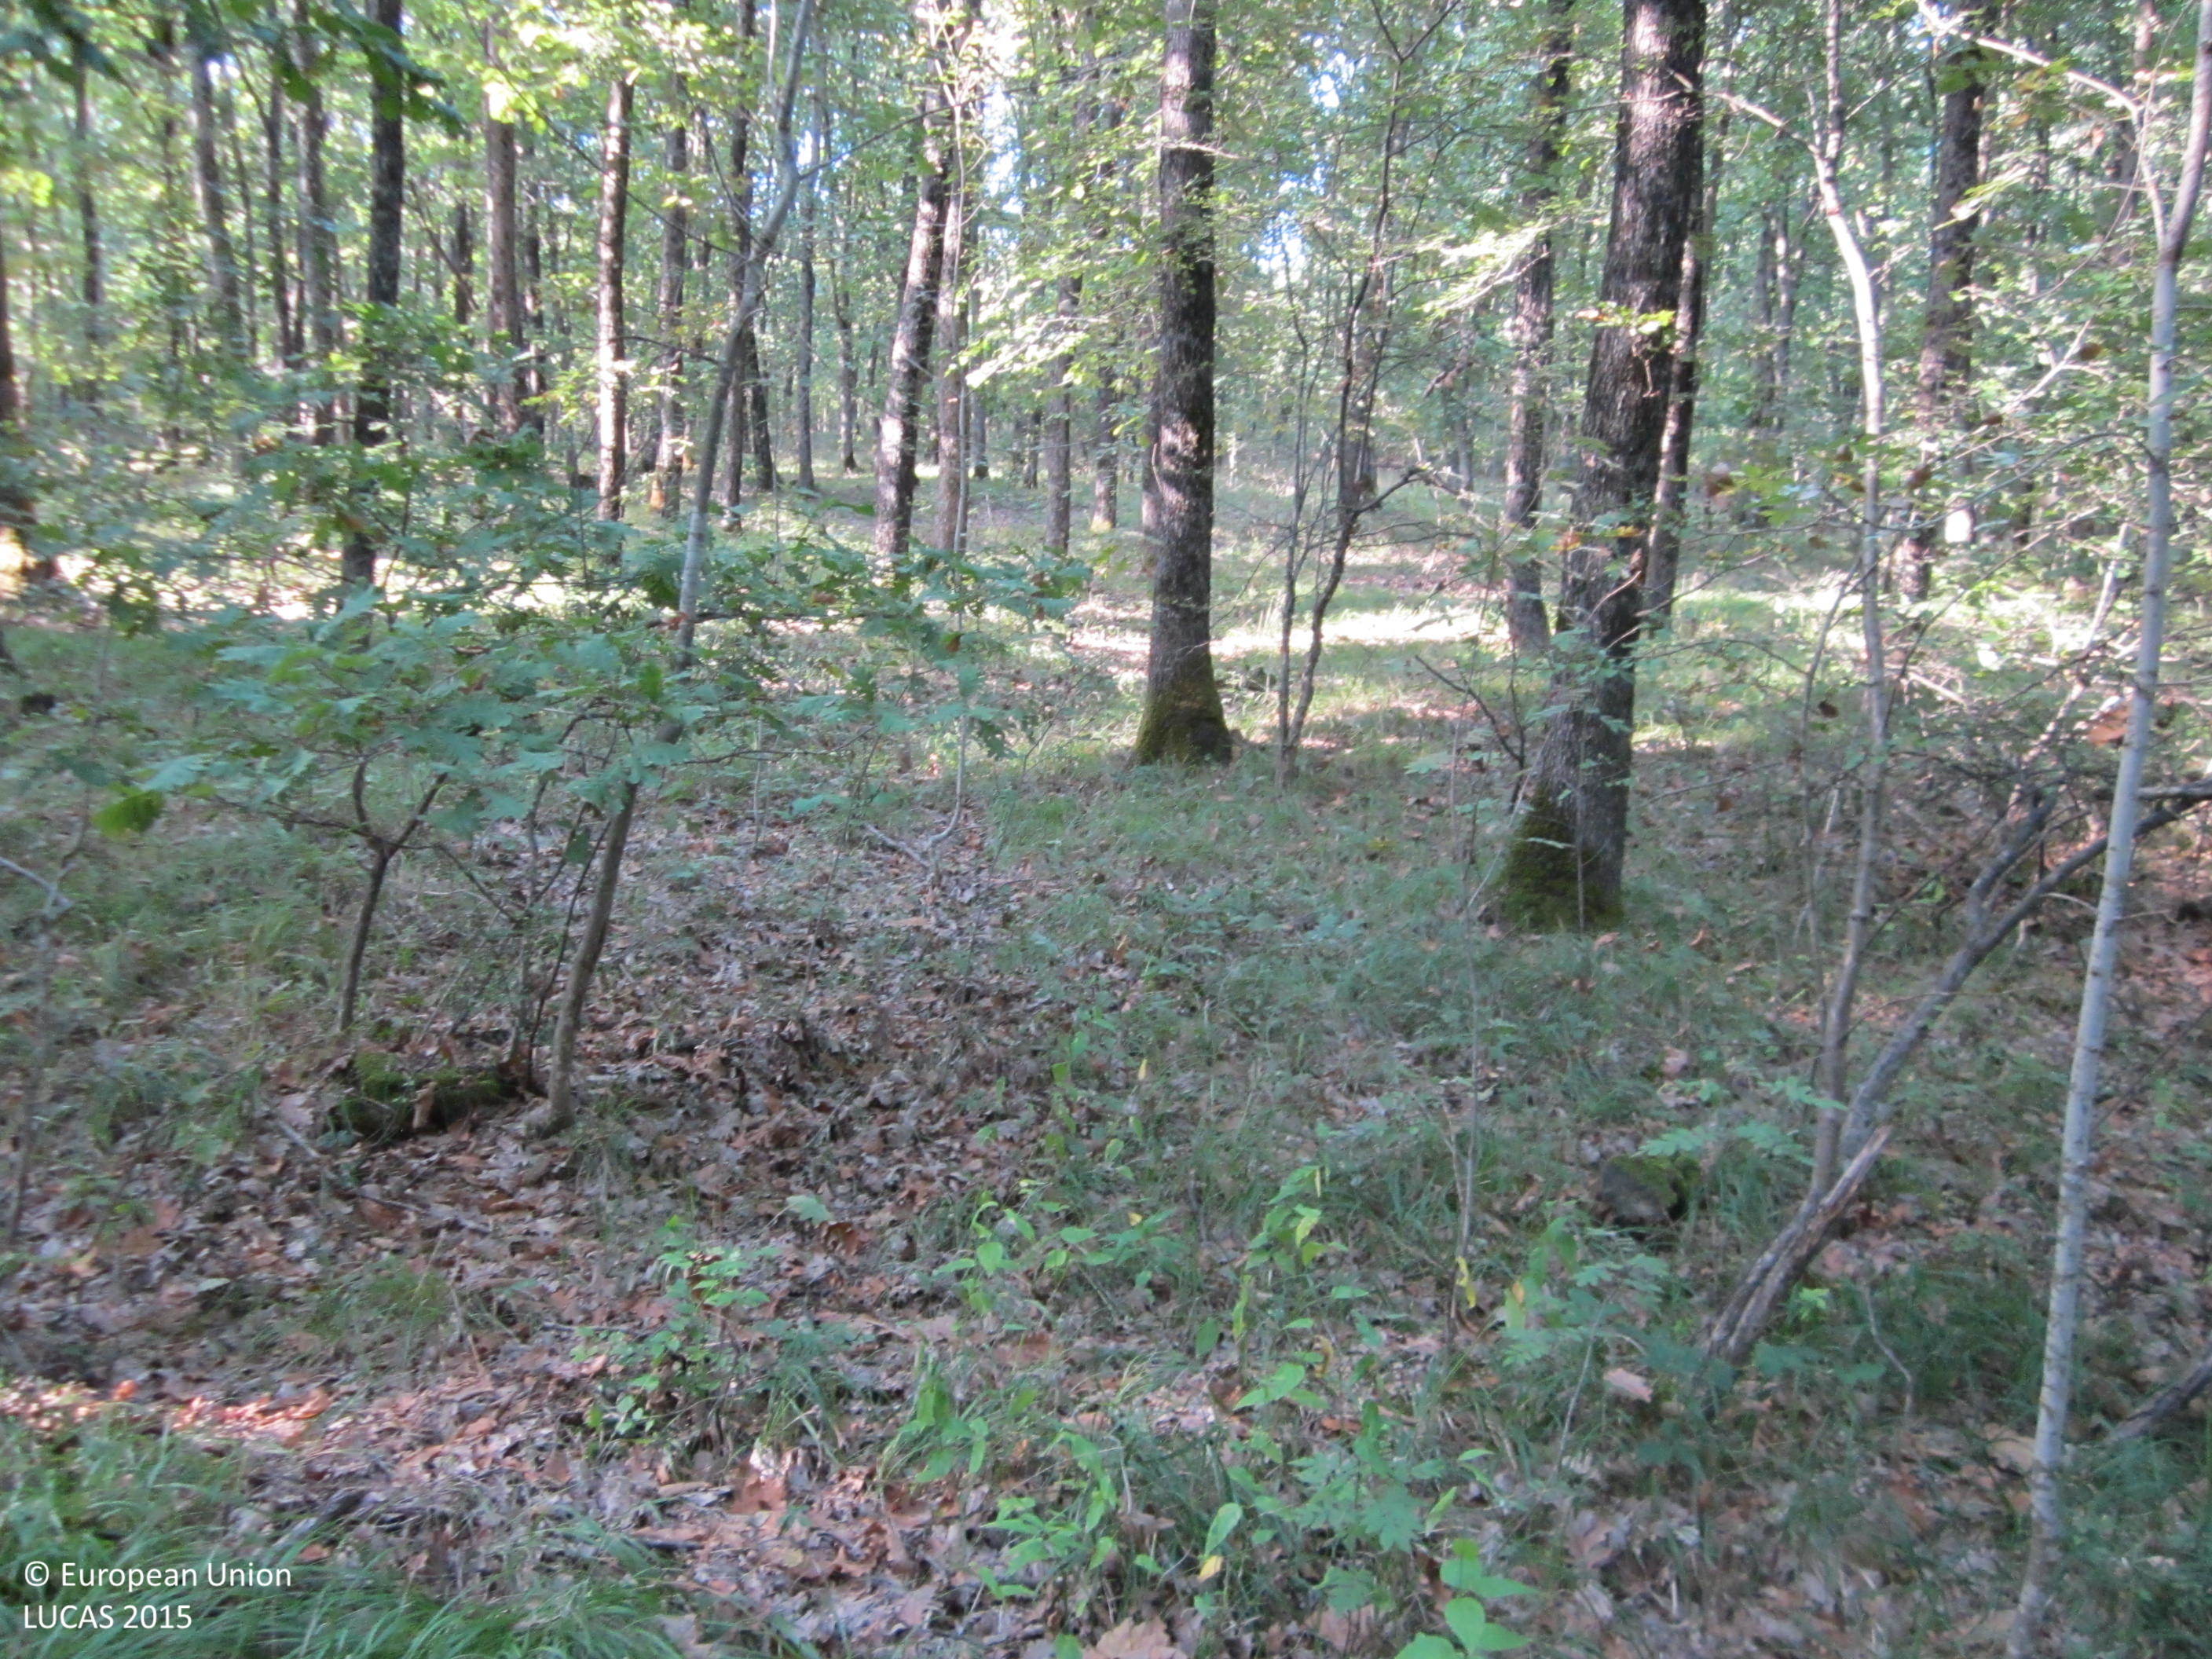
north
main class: Woodland
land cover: Broadleaved woodland
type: thermophilous deciduous forest
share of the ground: > 75 %
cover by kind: broadleaved forest trees 80 %, herbaceous plants 15 %, shrubs 5 %
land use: Forestry
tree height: > 5 m
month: September
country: BG
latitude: 42.1934
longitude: 27.6647
